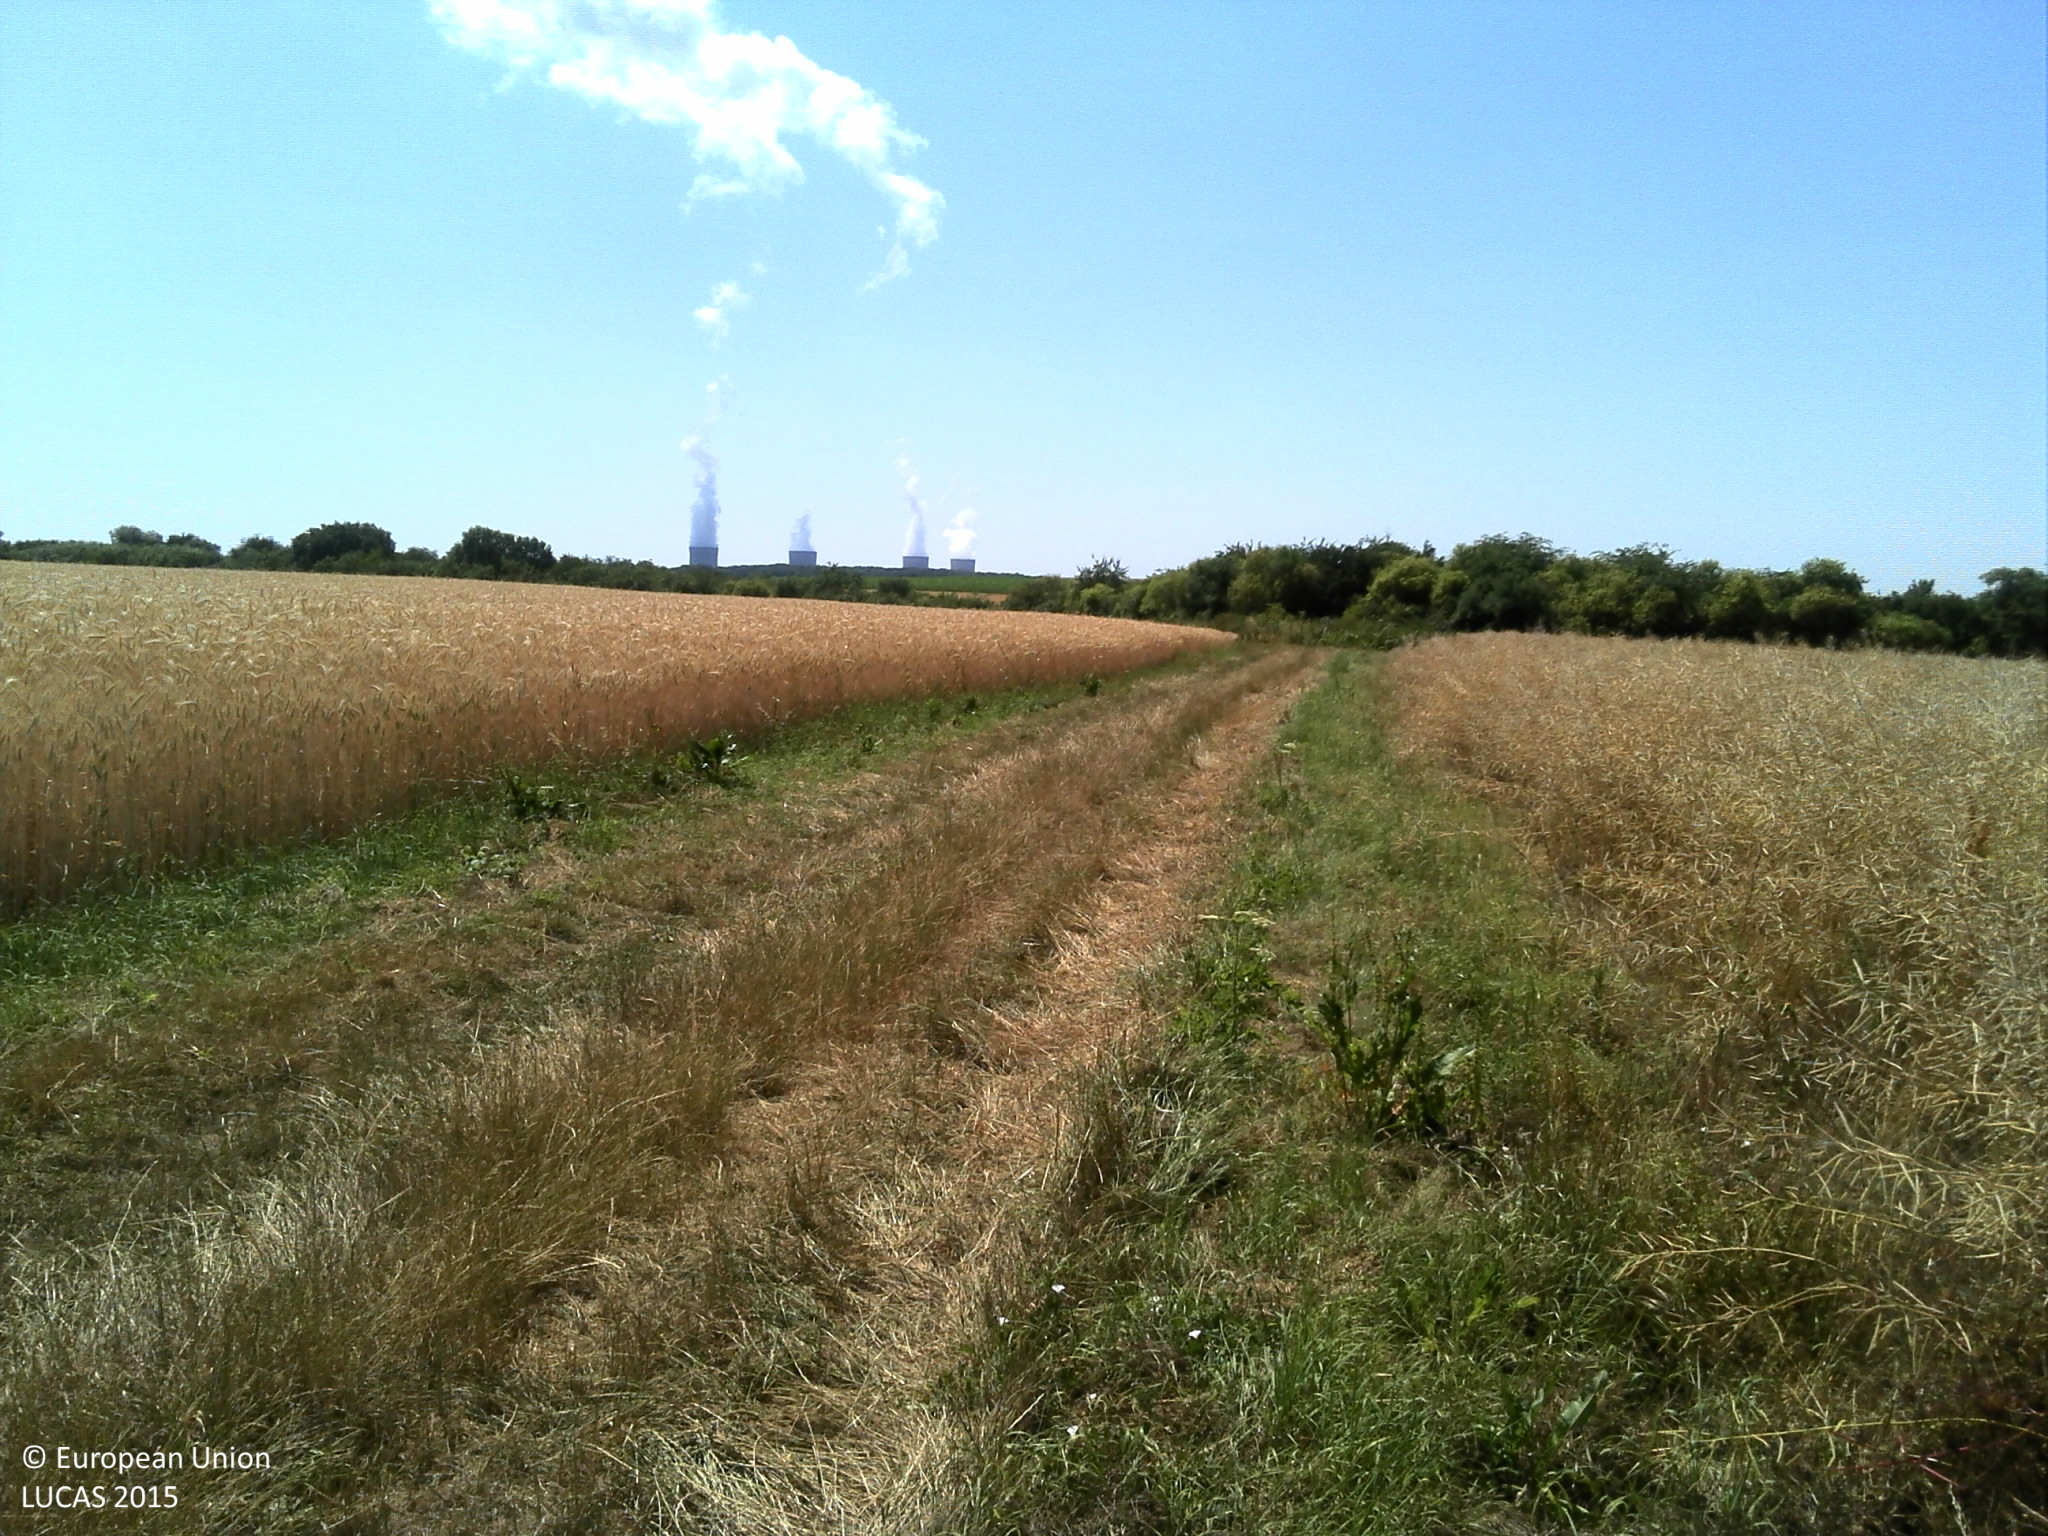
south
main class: Cropland
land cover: Rape and turnip rape
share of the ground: > 75 %
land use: Agriculture (excluding fallow land and kitchen gardens)
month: July
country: FR
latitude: 49.4730
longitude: 6.2045
